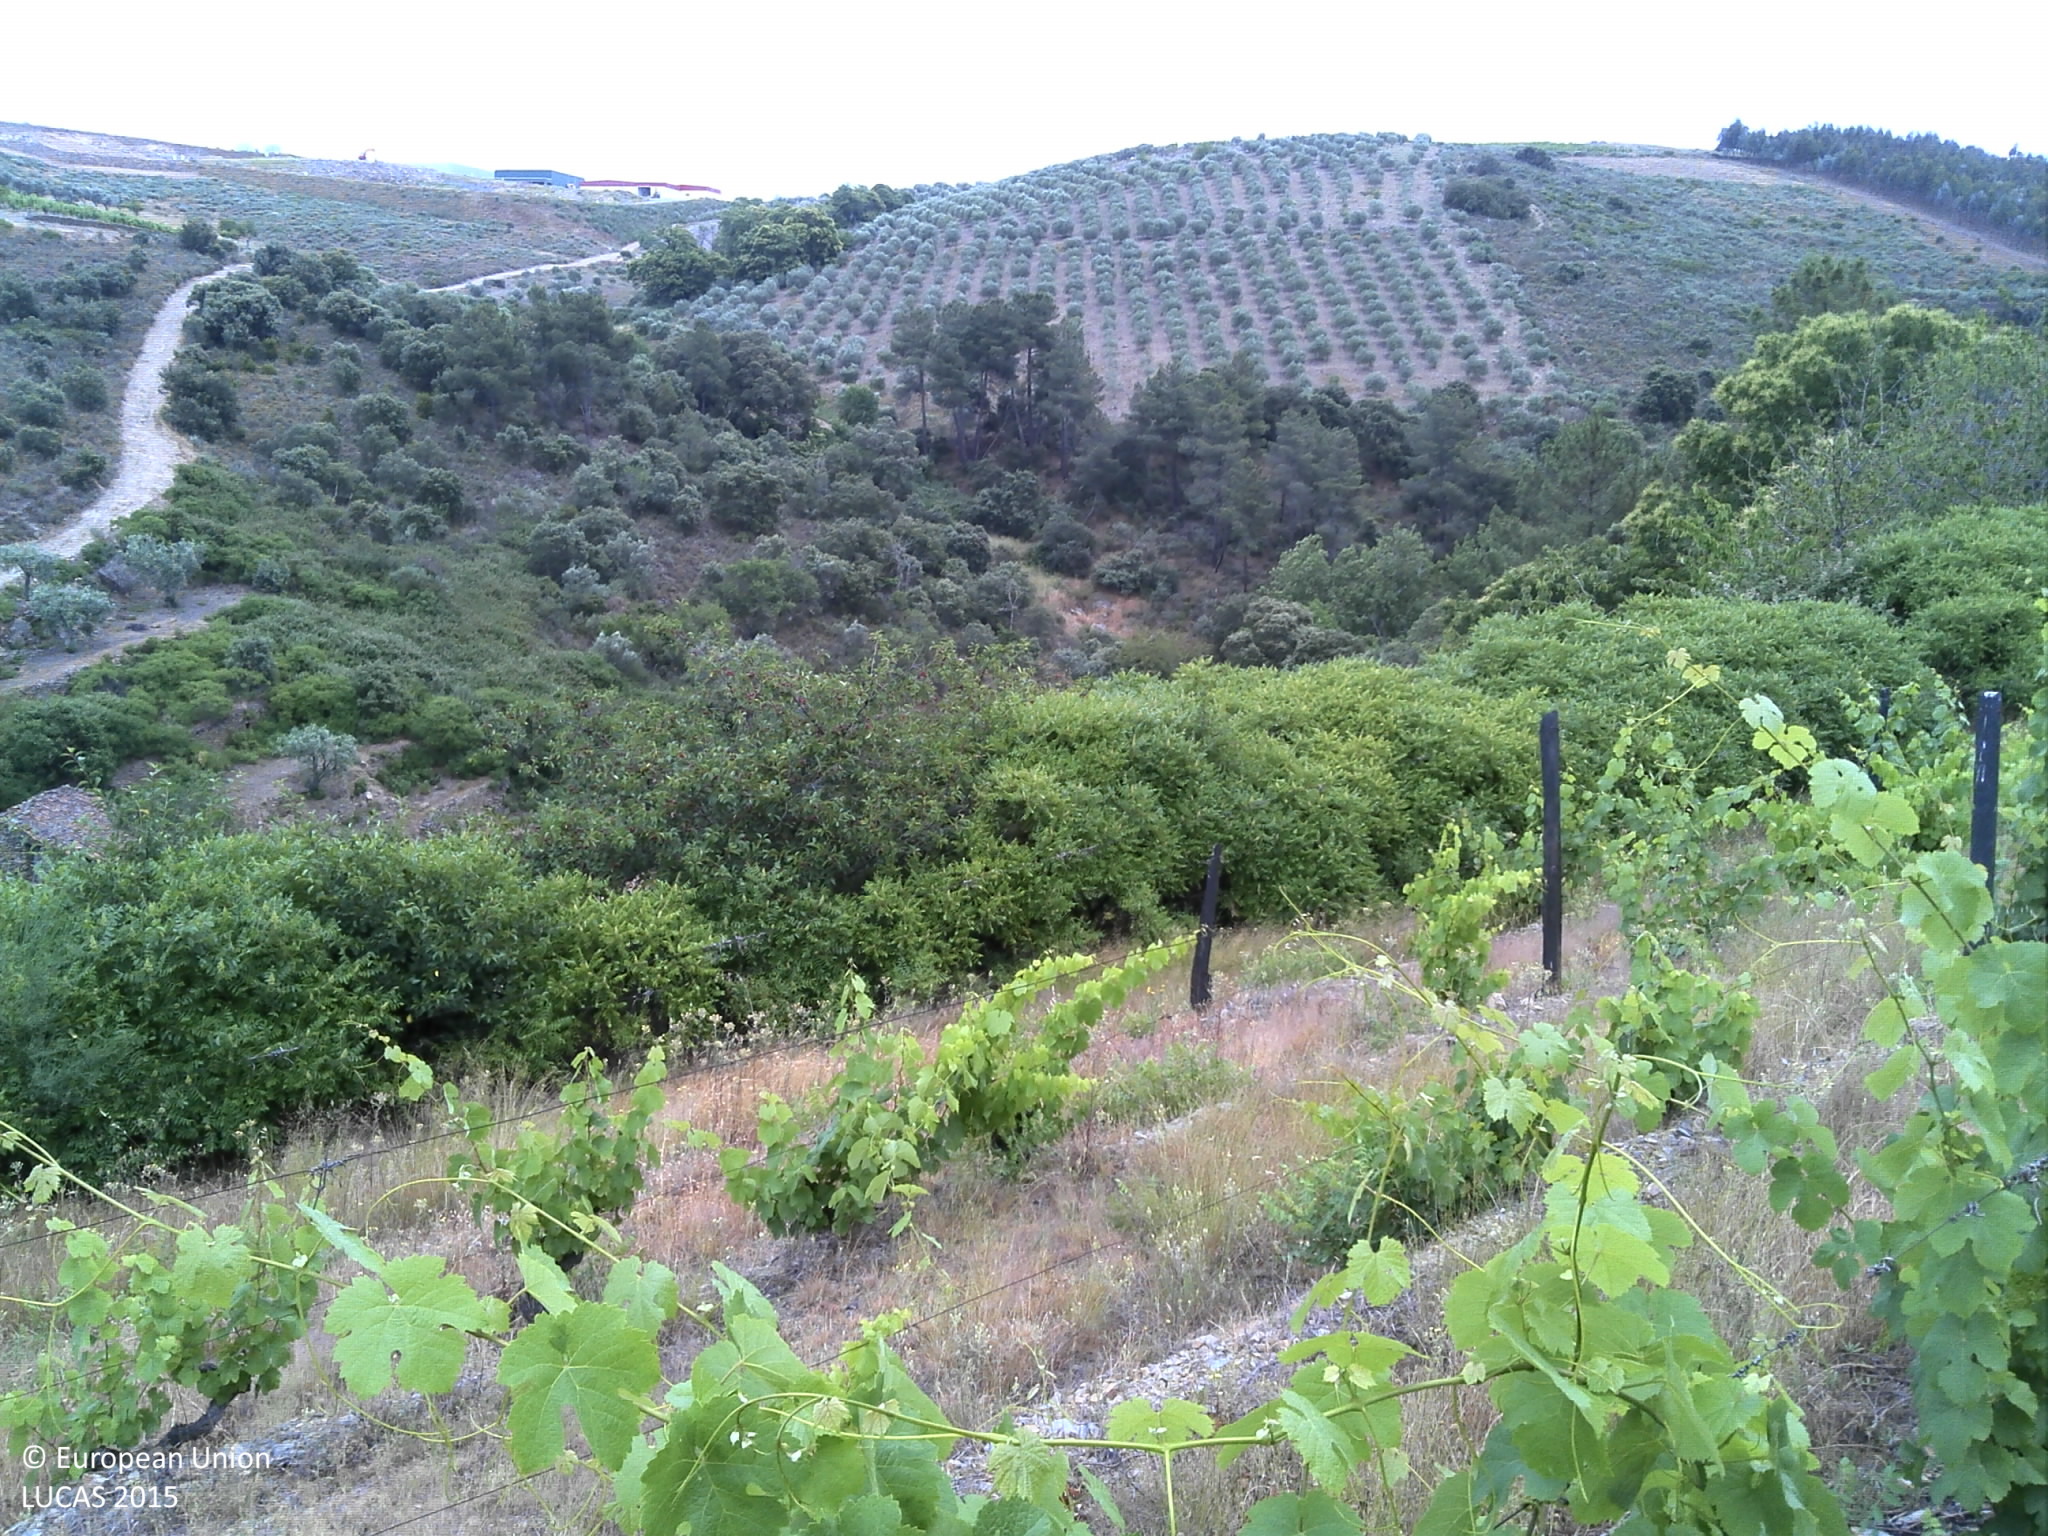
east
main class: Cropland
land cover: Vineyards
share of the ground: < 10 %
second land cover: Spontaneously vegetated surfaces
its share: 10 - 25 %
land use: Agriculture (excluding fallow land and kitchen gardens)
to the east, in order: Vineyards; Spontaneously vegetated surfaces; Shruby margins; Olive groves; Dry stone walls; Olive groves; Dry stone walls; Olive groves; Artificial constructions in urban areas; Spontaneously vegetated surfaces; Dry stone walls; Potatoes; Dry stone walls; Rivers and streams; Dry stone walls; Spontaneously vegetated surfaces; Shrubland with sparse tree cover; Olive groves
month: June
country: PT
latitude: 41.1469
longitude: -7.4324
